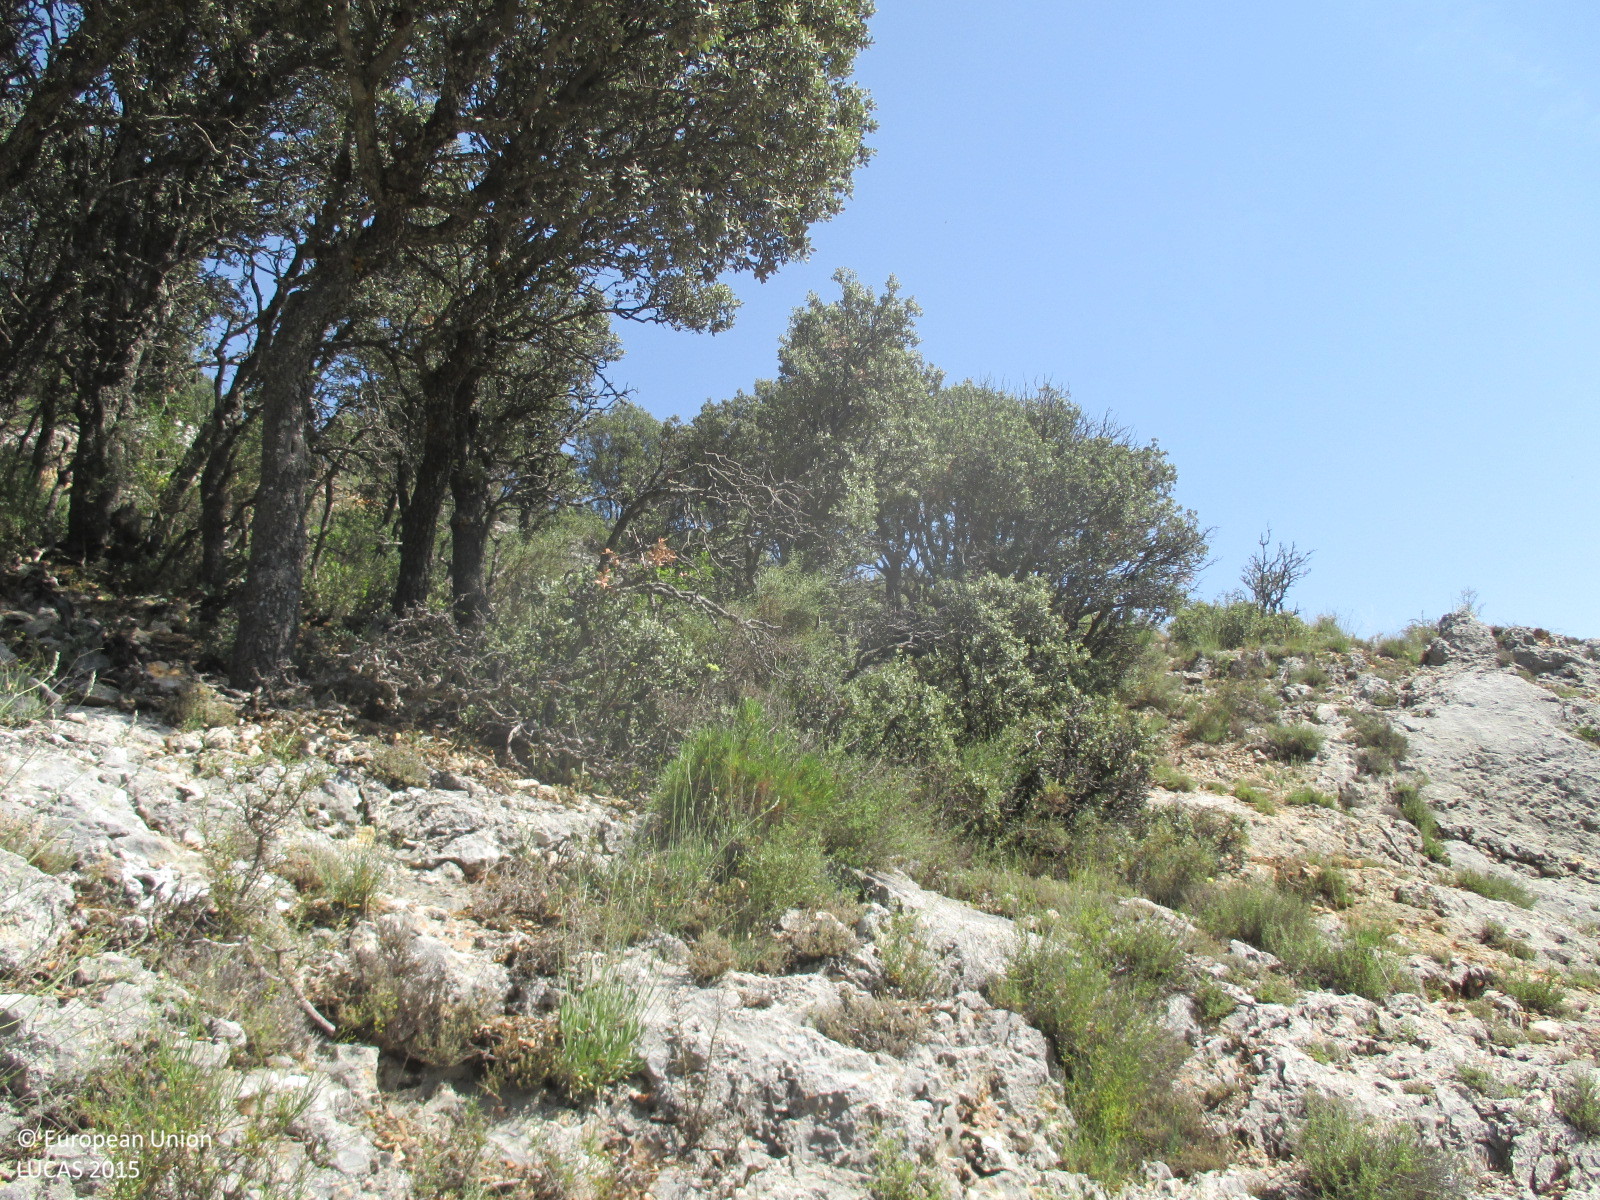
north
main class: Woodland
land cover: Pine dominated mixed woodland
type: alpine coniferous forest
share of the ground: > 75 %
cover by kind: coniferous forest trees 60 %, broadleaved forest trees 30 %, consolidated bare surface 10 %
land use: Forestry
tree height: > 5 m
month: July
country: ES
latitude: 38.1155
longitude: -2.4602
